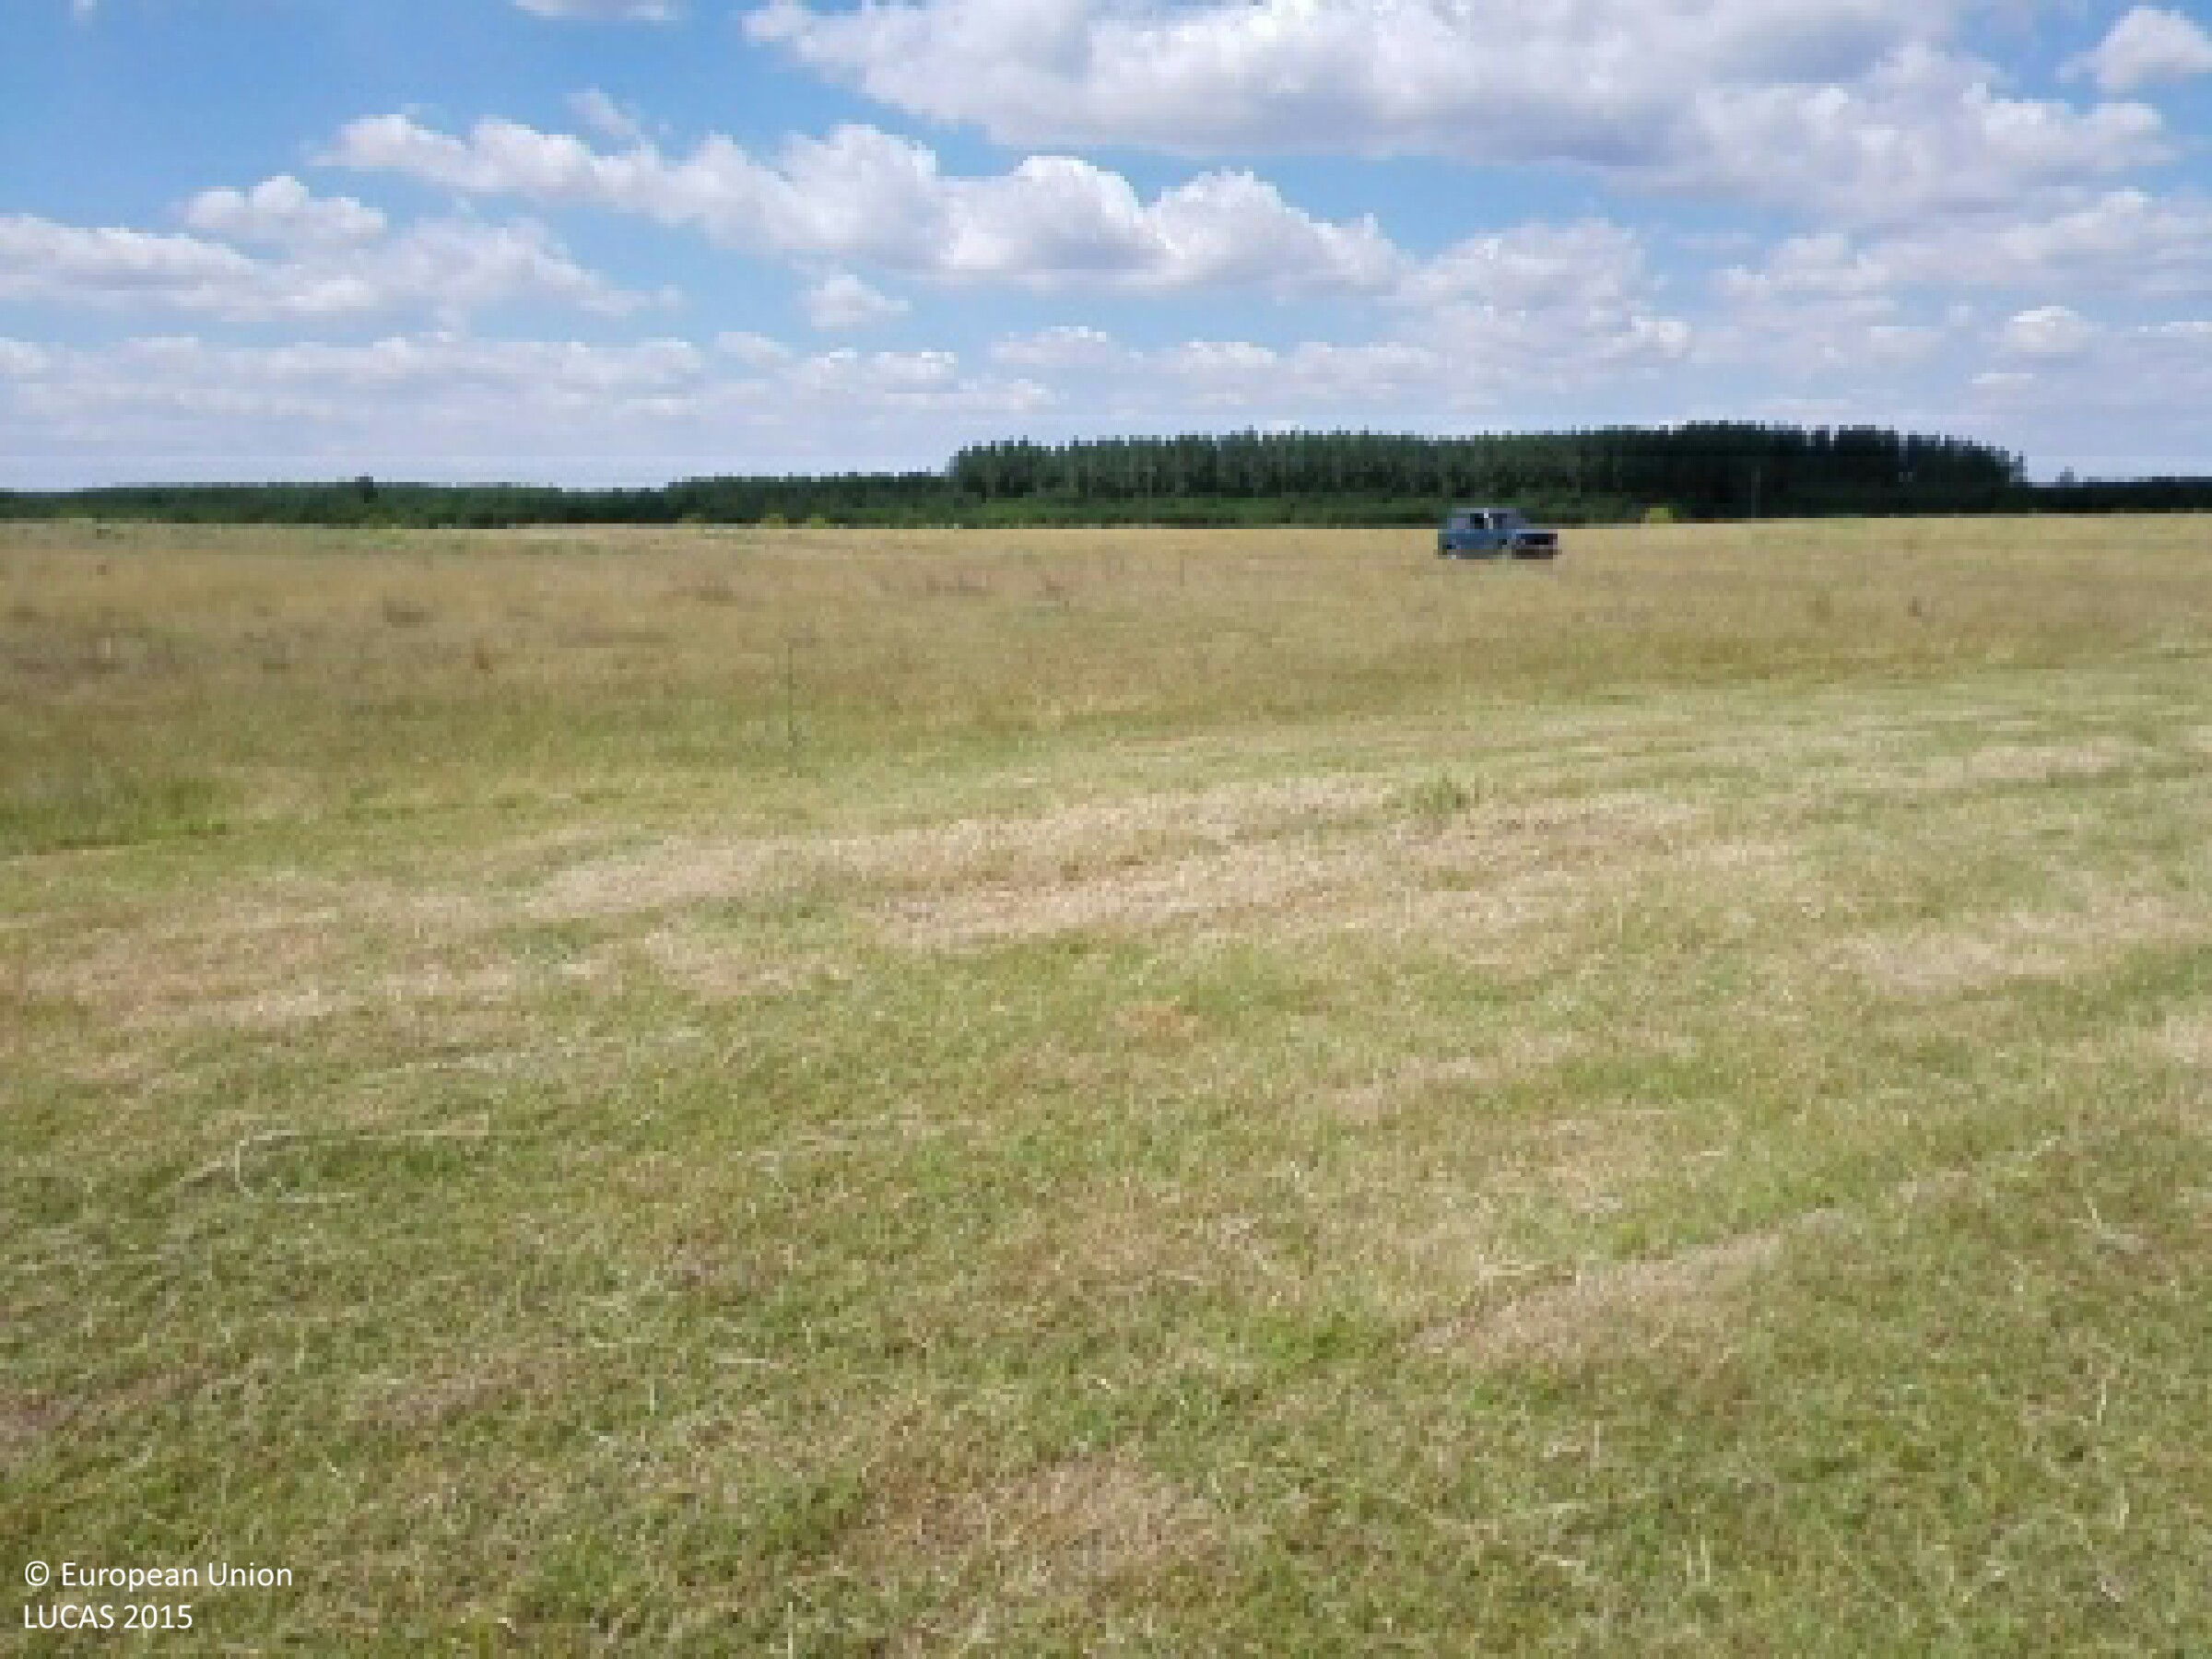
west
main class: Grassland
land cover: Grassland without tree/shrub cover
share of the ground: > 75 %
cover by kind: herbaceous plants 100 %
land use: Agriculture (excluding fallow land and kitchen gardens)
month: July
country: HU
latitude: 47.6886
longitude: 21.7039
